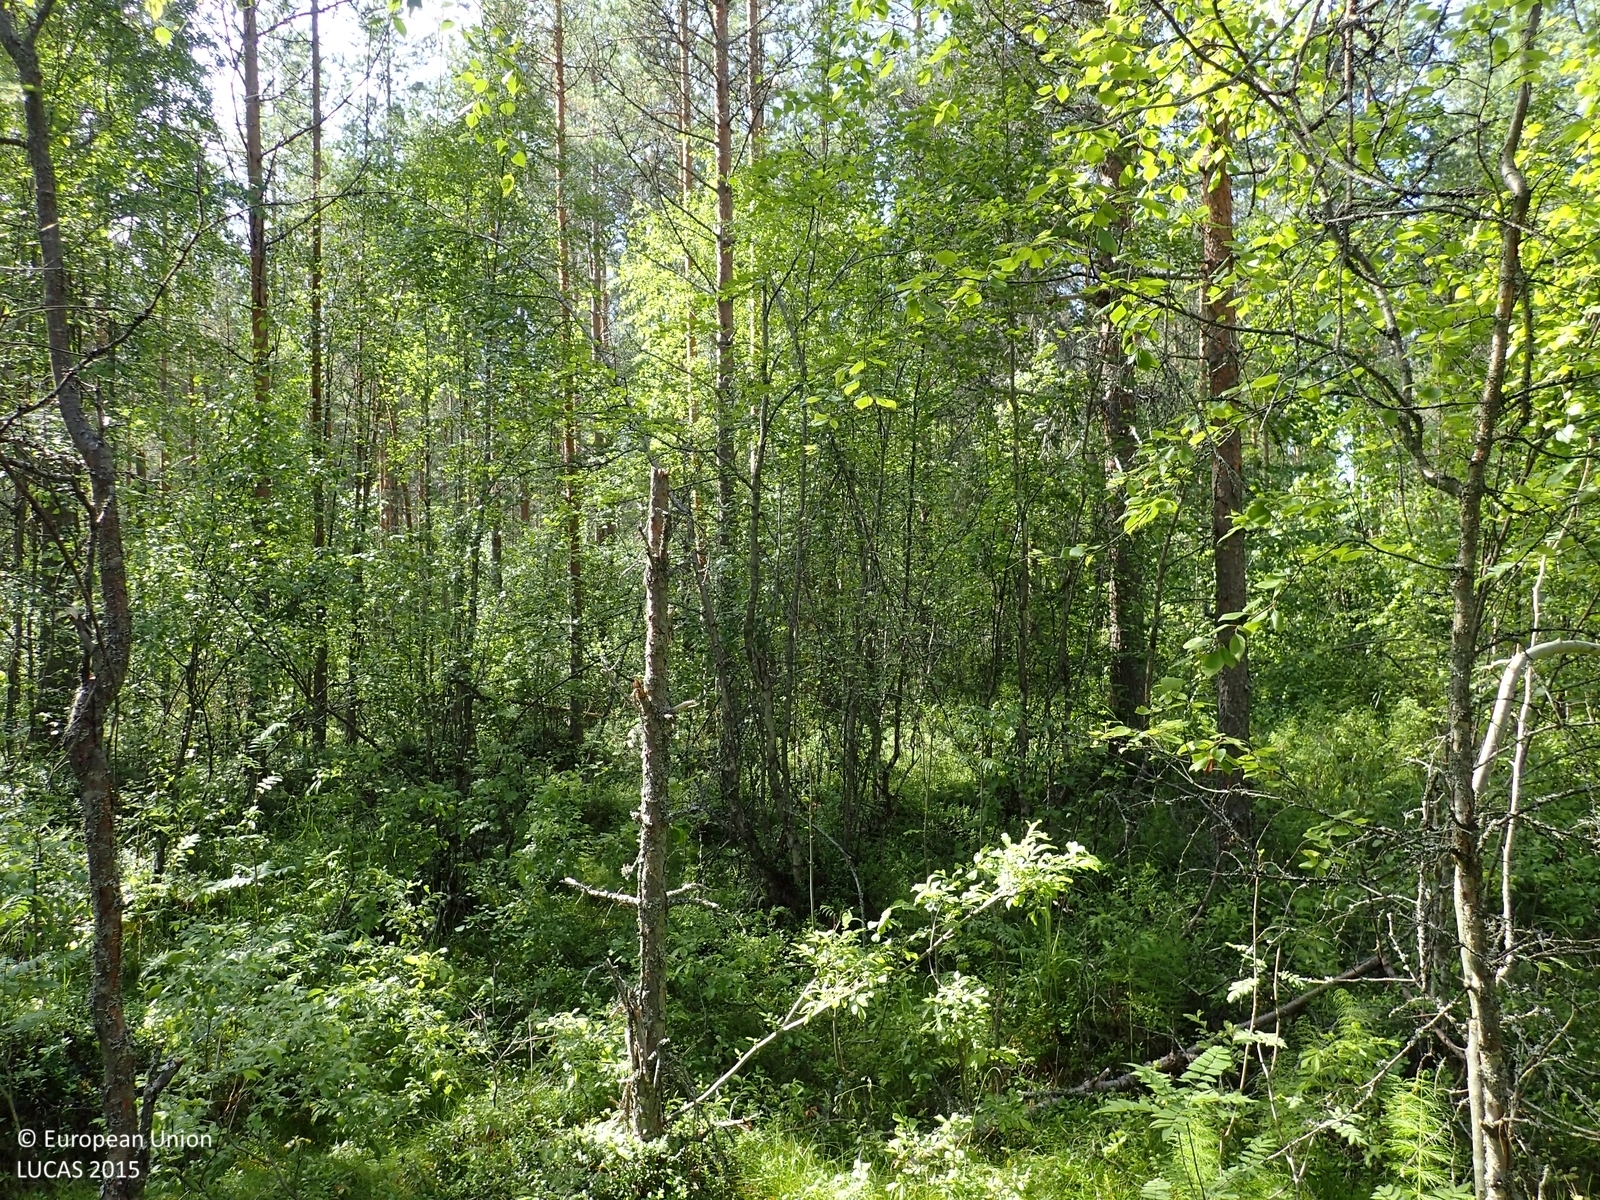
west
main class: Woodland
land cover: Pine dominated coniferous woodland
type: boreal forest
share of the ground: 50 - 75 %
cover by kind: coniferous forest trees 55 %, shrubs 30 %, broadleaved forest trees 10 %, herbaceous plants 5 %
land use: Forestry
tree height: > 5 m
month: July
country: FI
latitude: 62.9241
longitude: 23.6378
